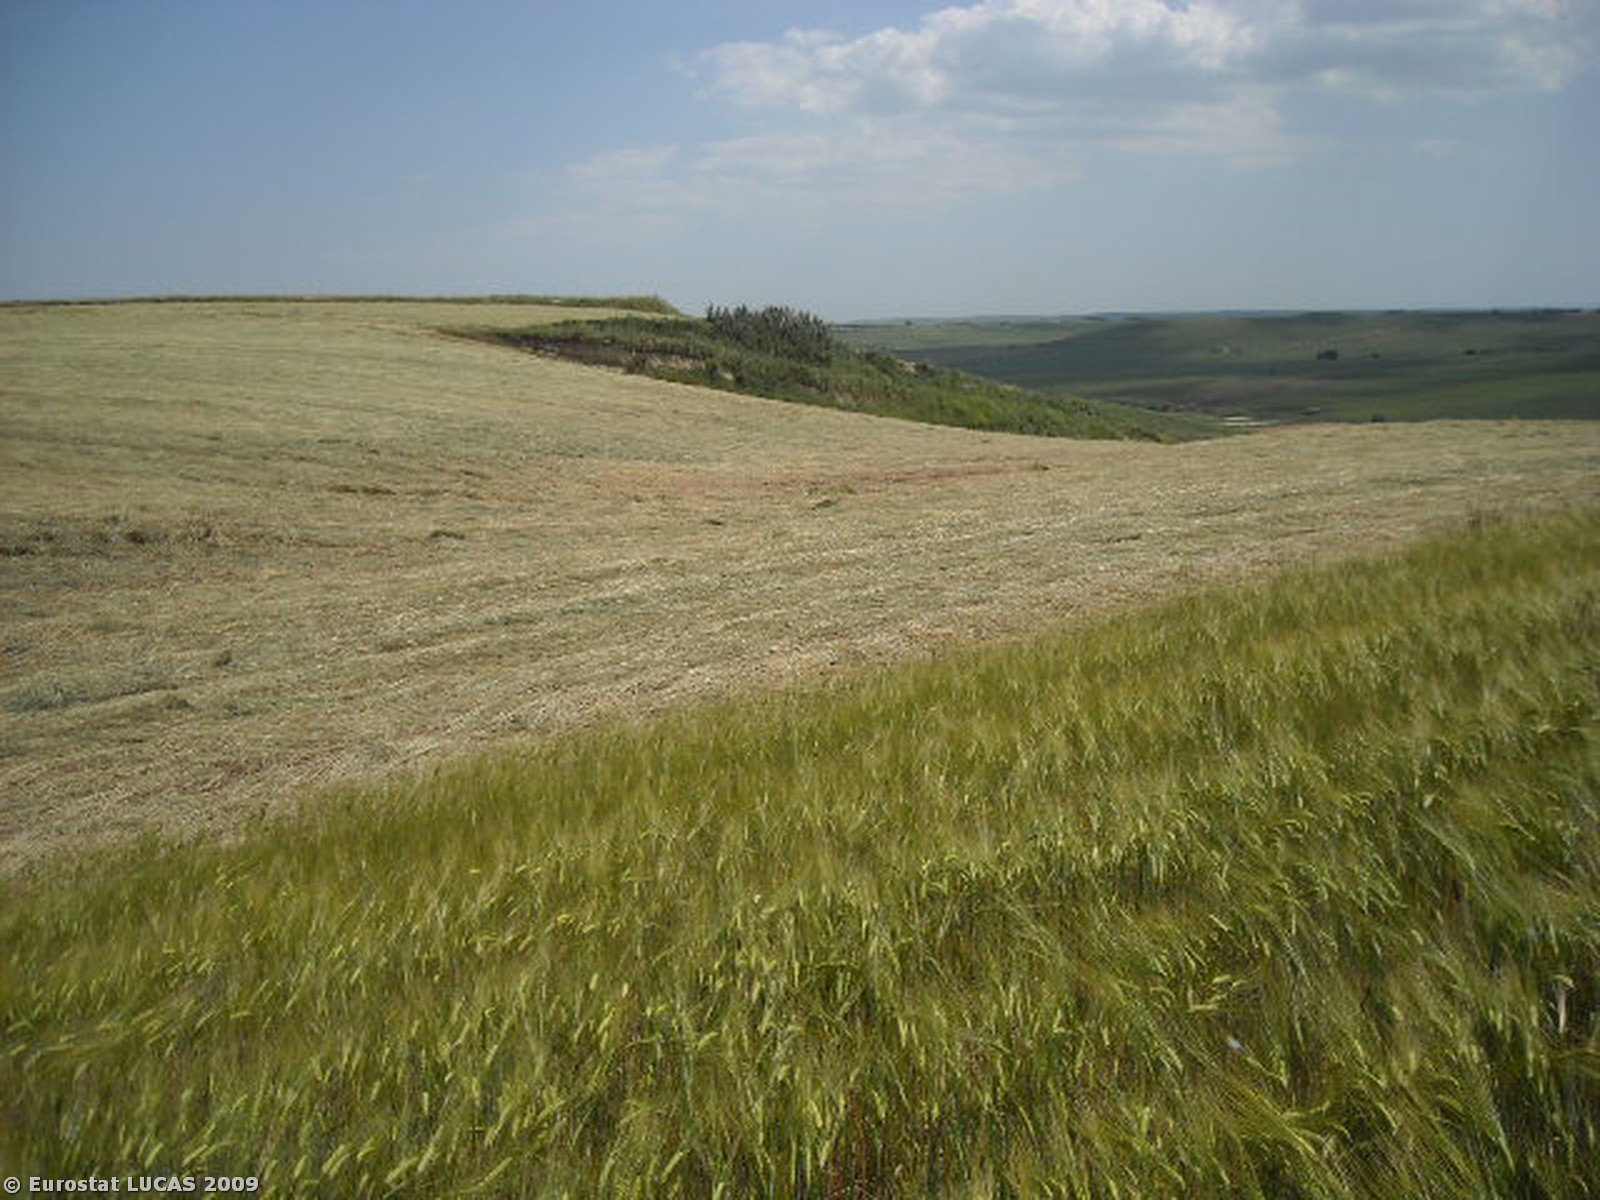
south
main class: Cropland
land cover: Barley
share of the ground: > 75 %
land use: Agriculture (excluding fallow land and kitchen gardens)
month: May
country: IT
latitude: 40.8974
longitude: 16.3289
